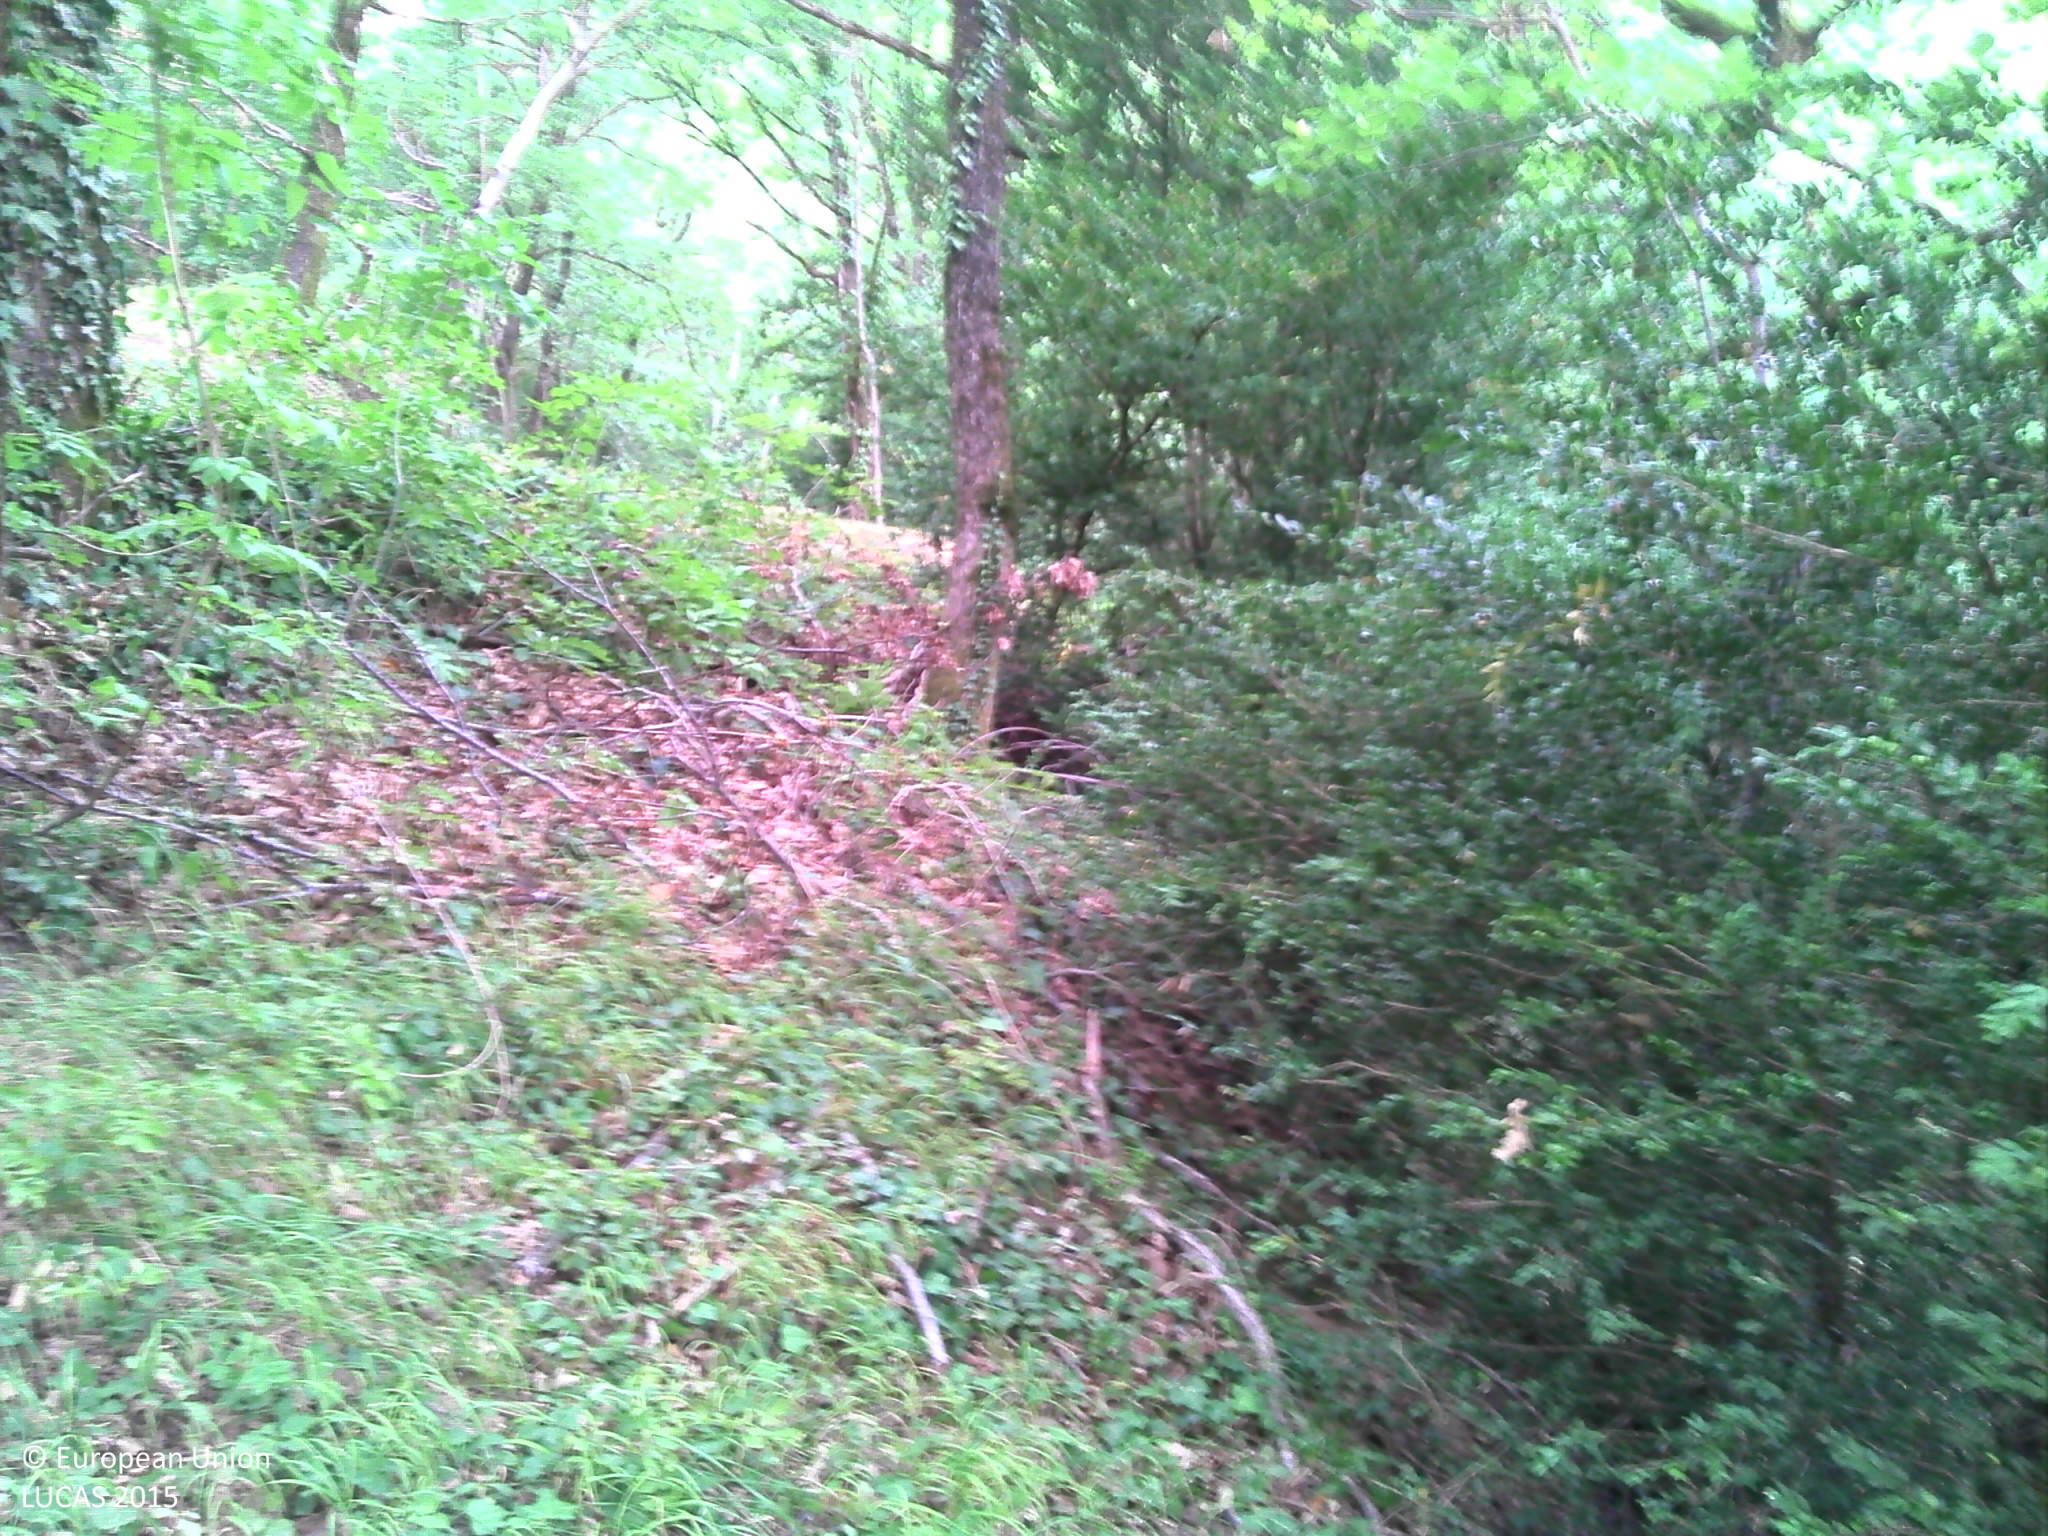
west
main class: Woodland
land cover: Broadleaved woodland
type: broadleaved evergreen forest
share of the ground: > 75 %
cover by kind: broadleaved forest trees 100 %
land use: Semi-natural and natural areas not in use
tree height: > 5 m
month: July
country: FR
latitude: 44.7527
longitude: 4.6123
